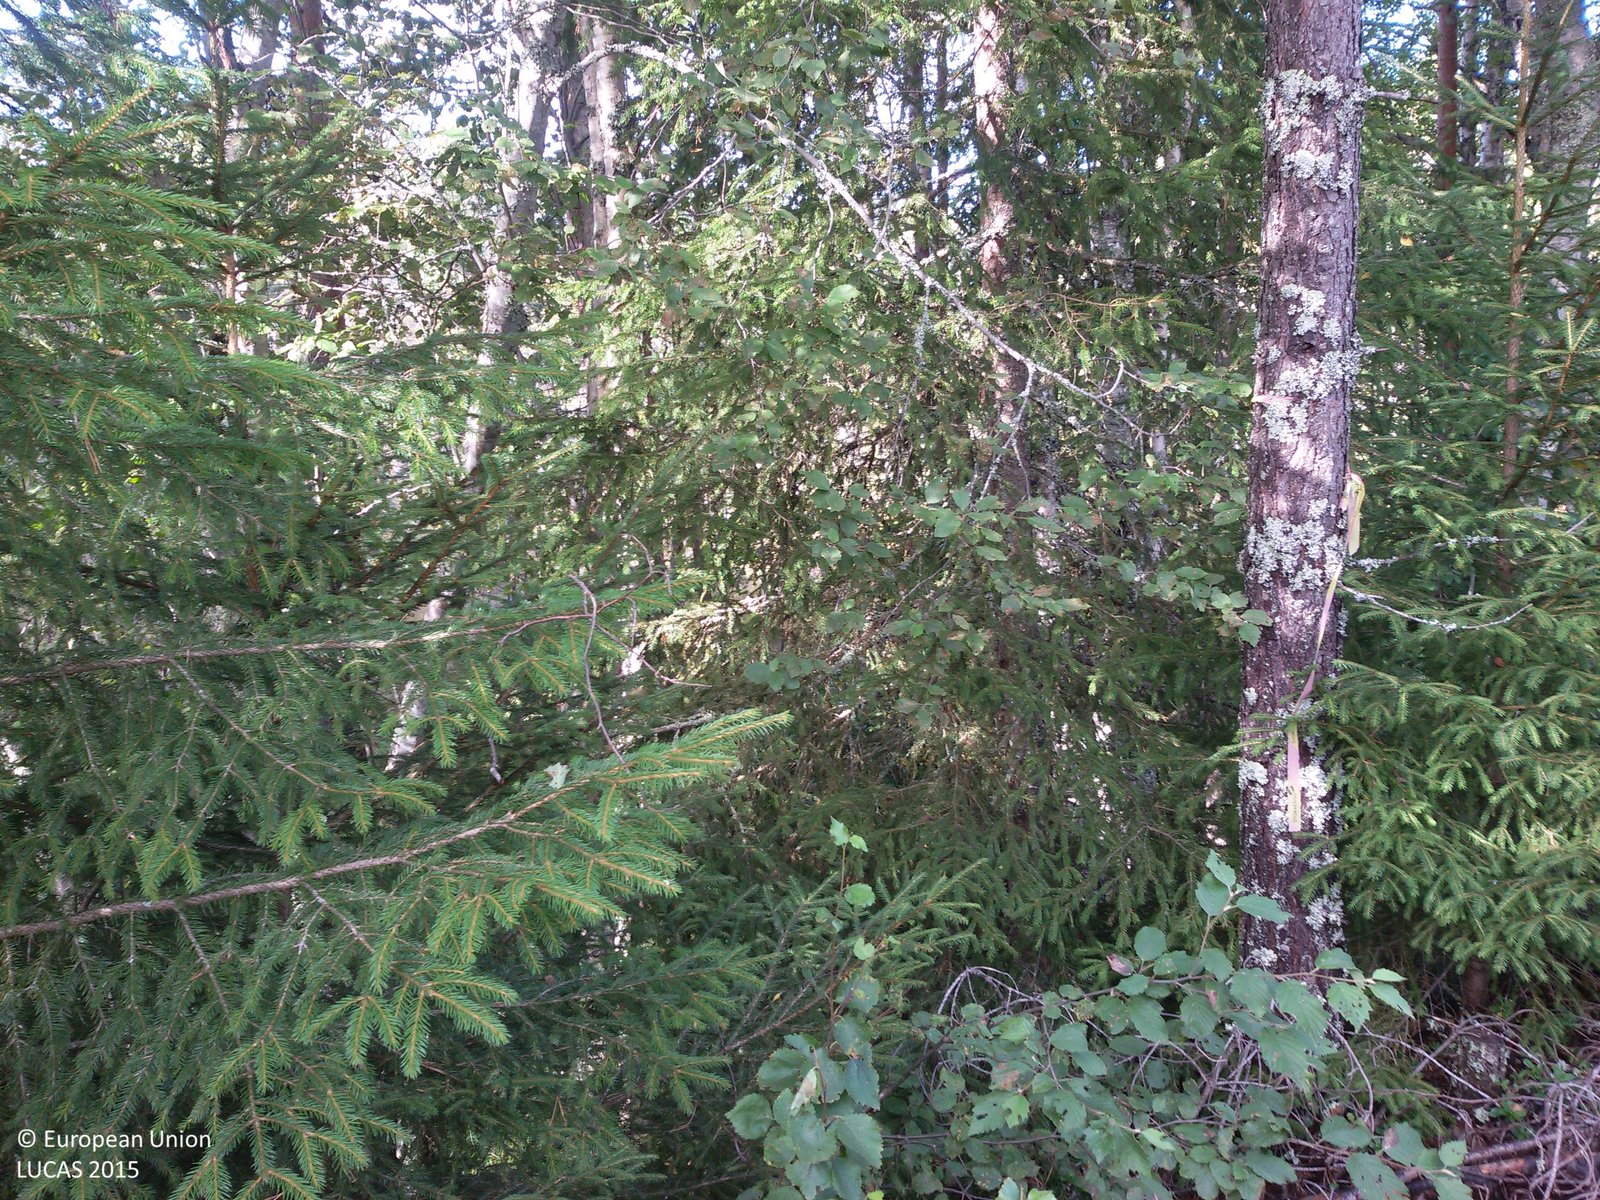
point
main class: Woodland
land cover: Spruce dominated mixed woodland
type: boreal forest
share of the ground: 50 - 75 %
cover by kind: broadleaved forest trees 40 %, coniferous forest trees 30 %, herbaceous plants 30 %
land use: Forestry
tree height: > 5 m
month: September
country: SE
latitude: 61.0517
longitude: 15.4123
